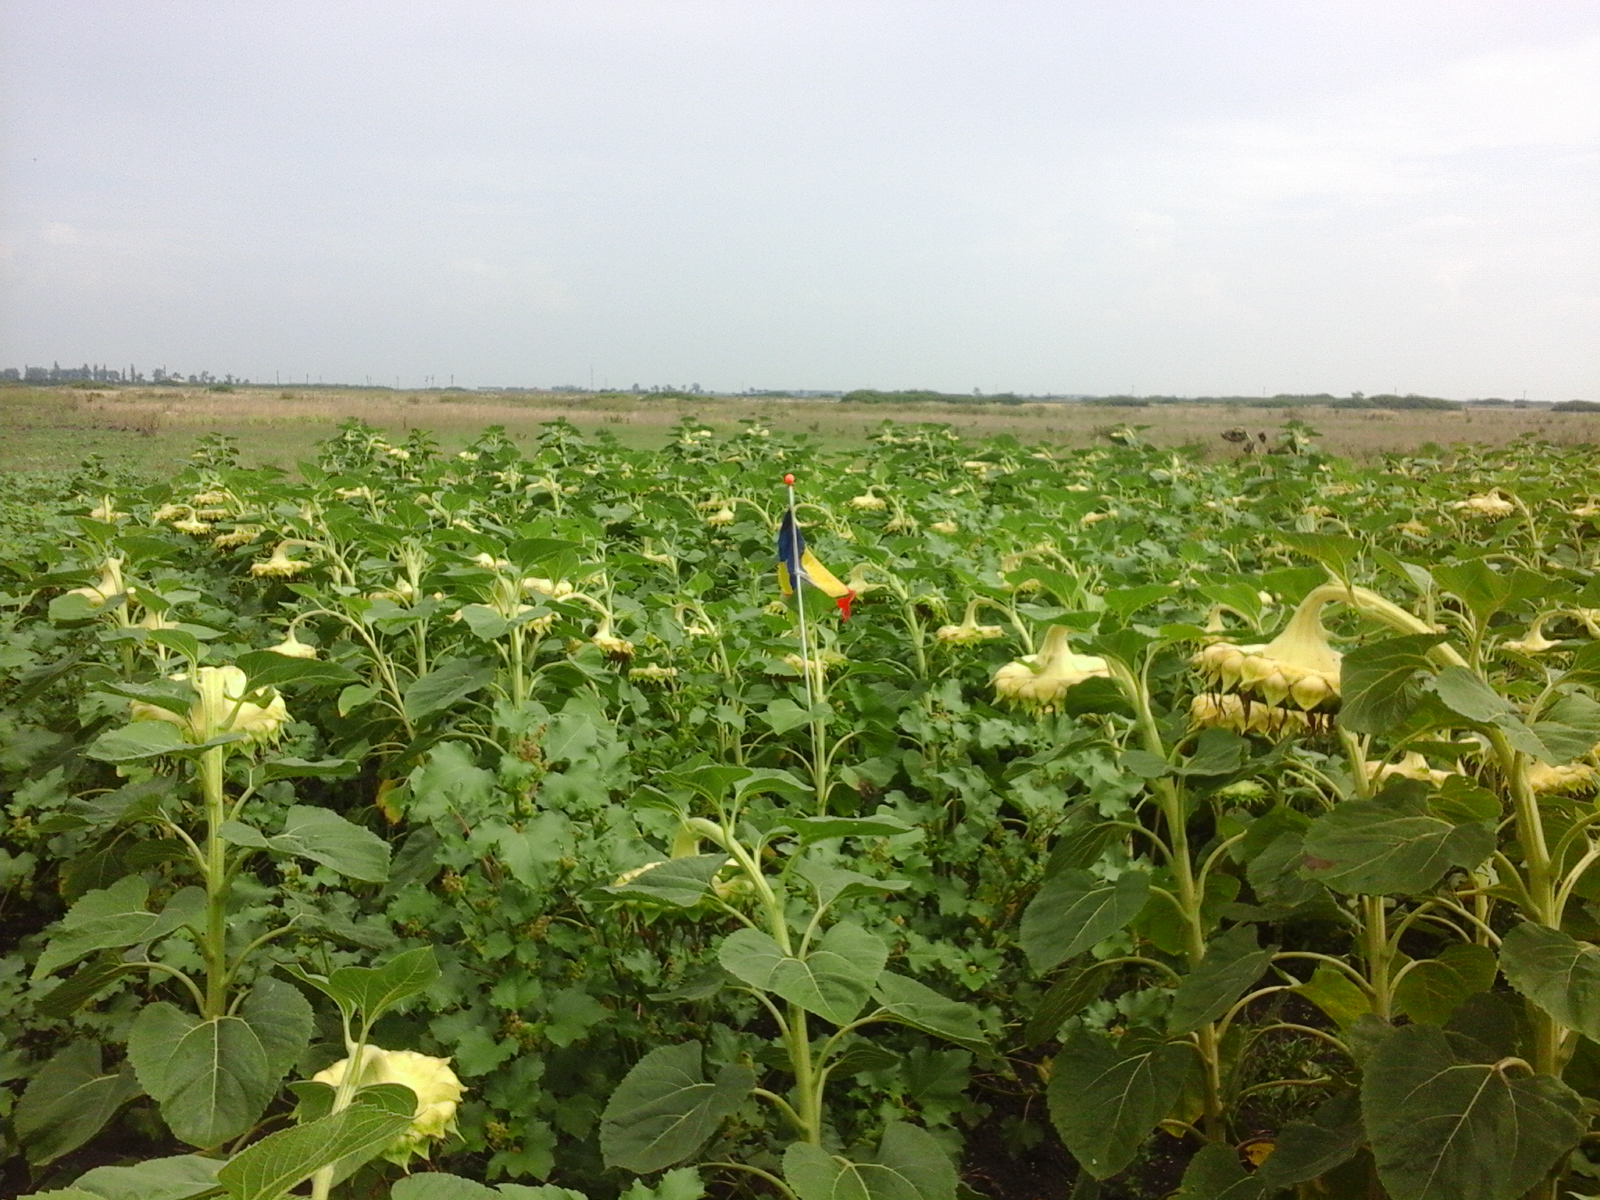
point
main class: Cropland
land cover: Sunflower
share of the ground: > 75 %
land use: Agriculture (excluding fallow land and kitchen gardens)
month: August
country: RO
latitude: 46.6207
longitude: 21.4912
